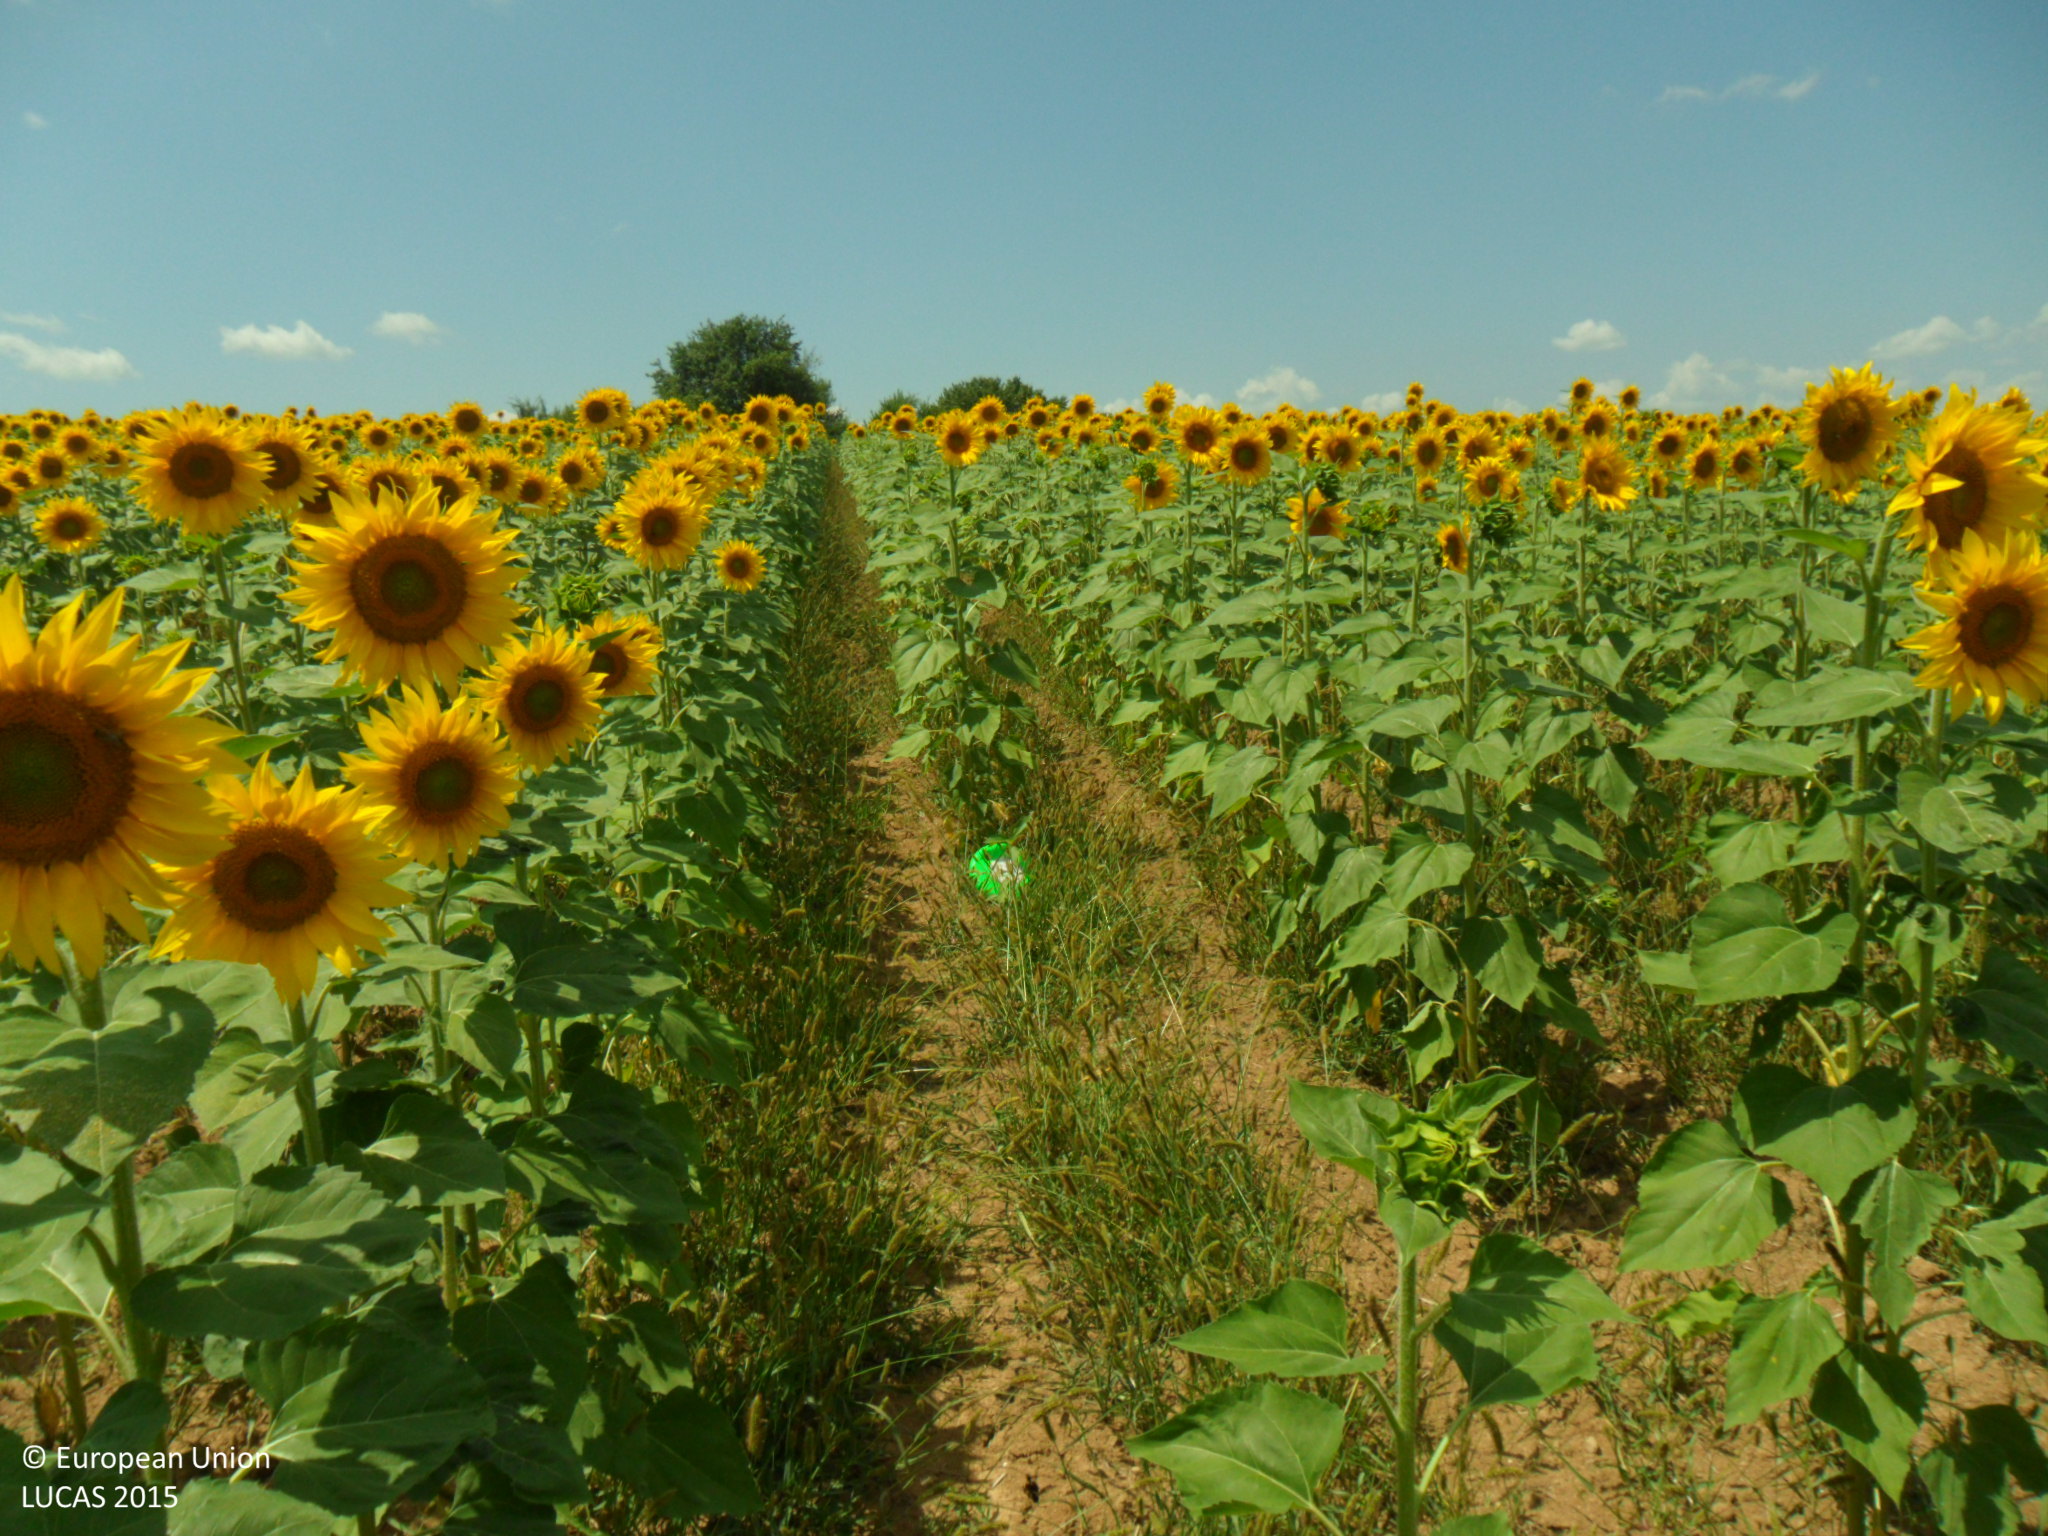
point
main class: Cropland
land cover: Sunflower
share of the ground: > 75 %
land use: Agriculture (excluding fallow land and kitchen gardens)
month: July
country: BG
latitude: 43.0431
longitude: 27.0152
